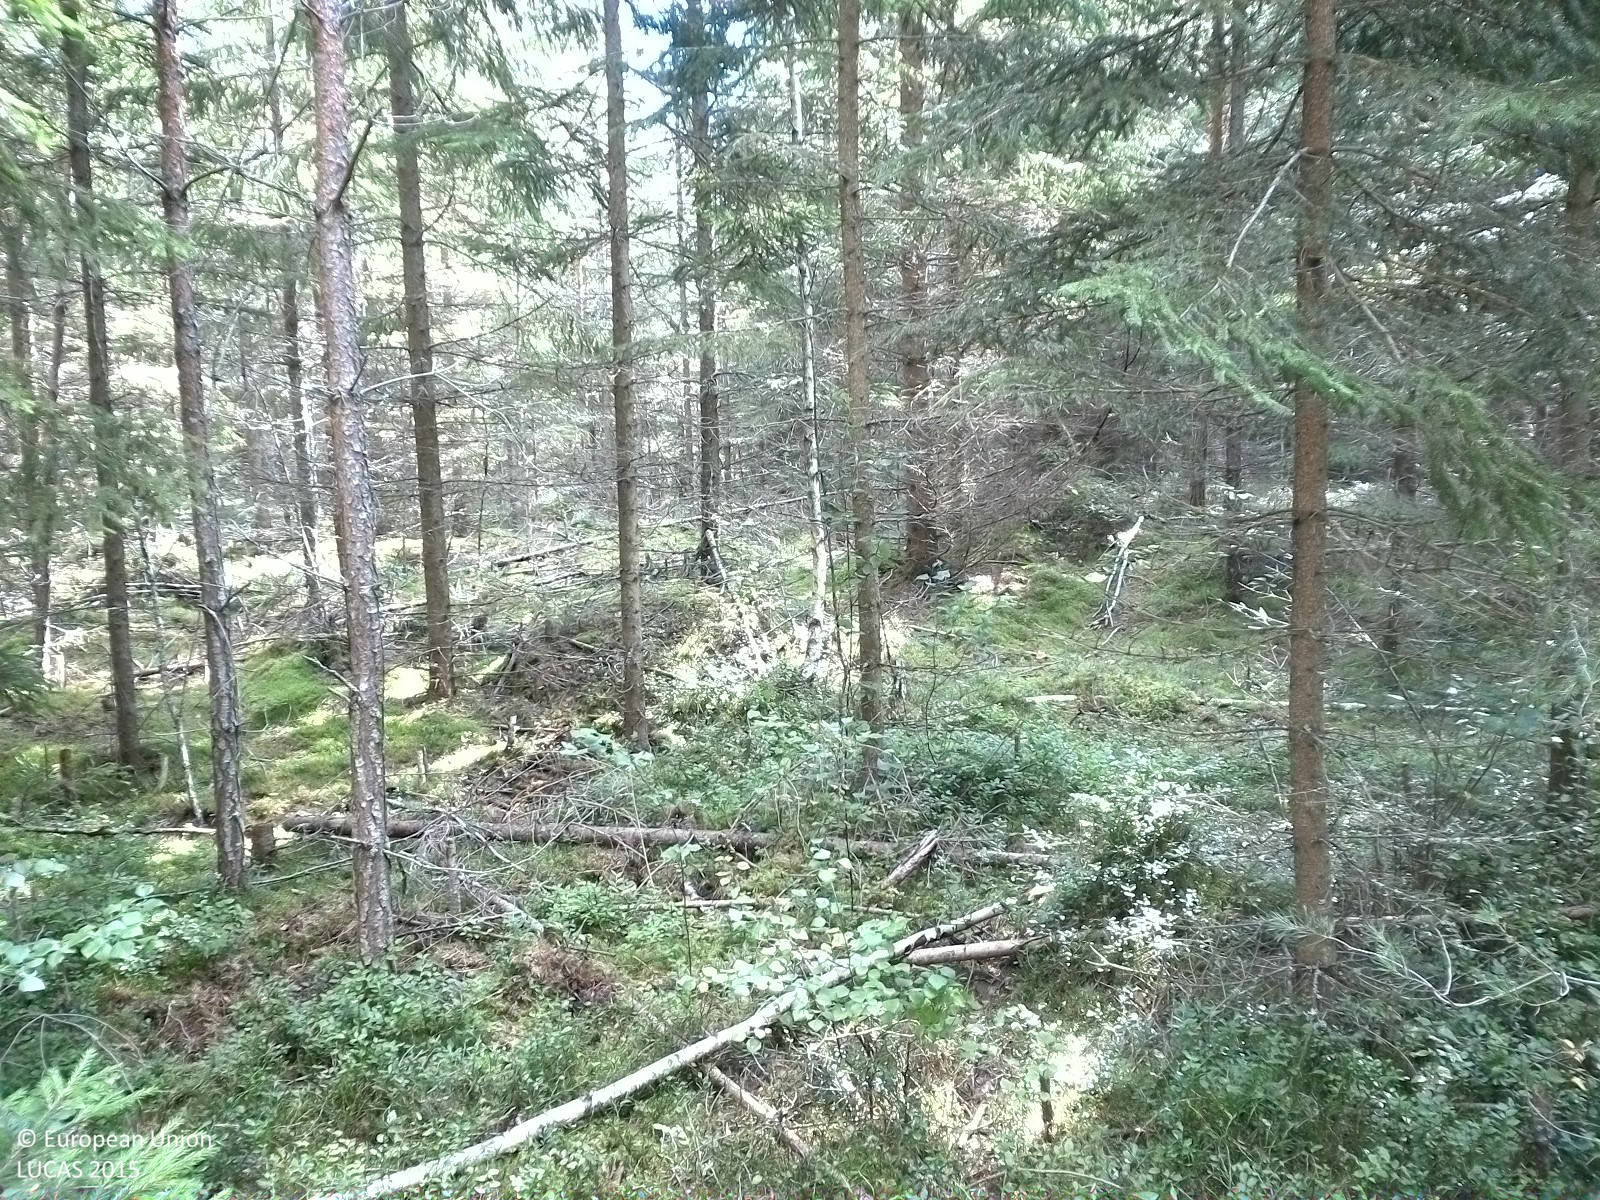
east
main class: Woodland
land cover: Other coniferous woodland
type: boreal forest
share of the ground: 50 - 75 %
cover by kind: coniferous forest trees 60 %, herbaceous plants 30 %, broadleaved forest trees 5 %, lichens and mosses 5 %
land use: Forestry
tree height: < 5 m
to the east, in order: Other coniferous woodland; Tracks; Other mixed woodland; Pine dominated mixed woodland; Tracks; Pine dominated mixed woodland
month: August
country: SE
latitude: 59.1474
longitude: 15.1842
